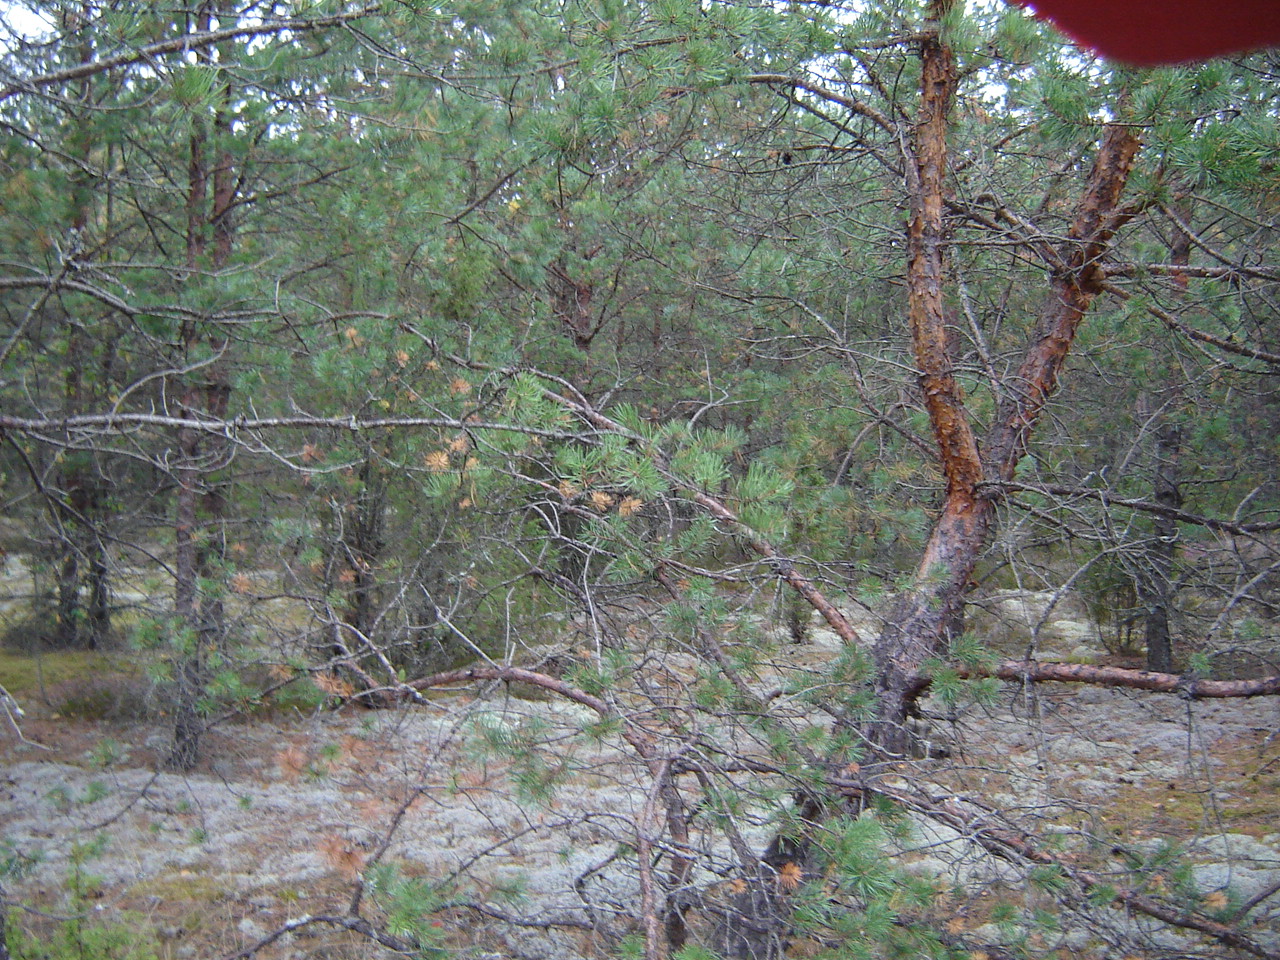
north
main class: Woodland
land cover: Pine dominated coniferous woodland
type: hemiboreal forest and nemoral coniferous forest and mixed broadleaved-coniferous forest
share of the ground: > 75 %
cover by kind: coniferous forest trees 85 %, lichens and mosses 15 %
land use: Forestry
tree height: > 5 m
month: September
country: LT
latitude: 54.3305
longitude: 24.8275
